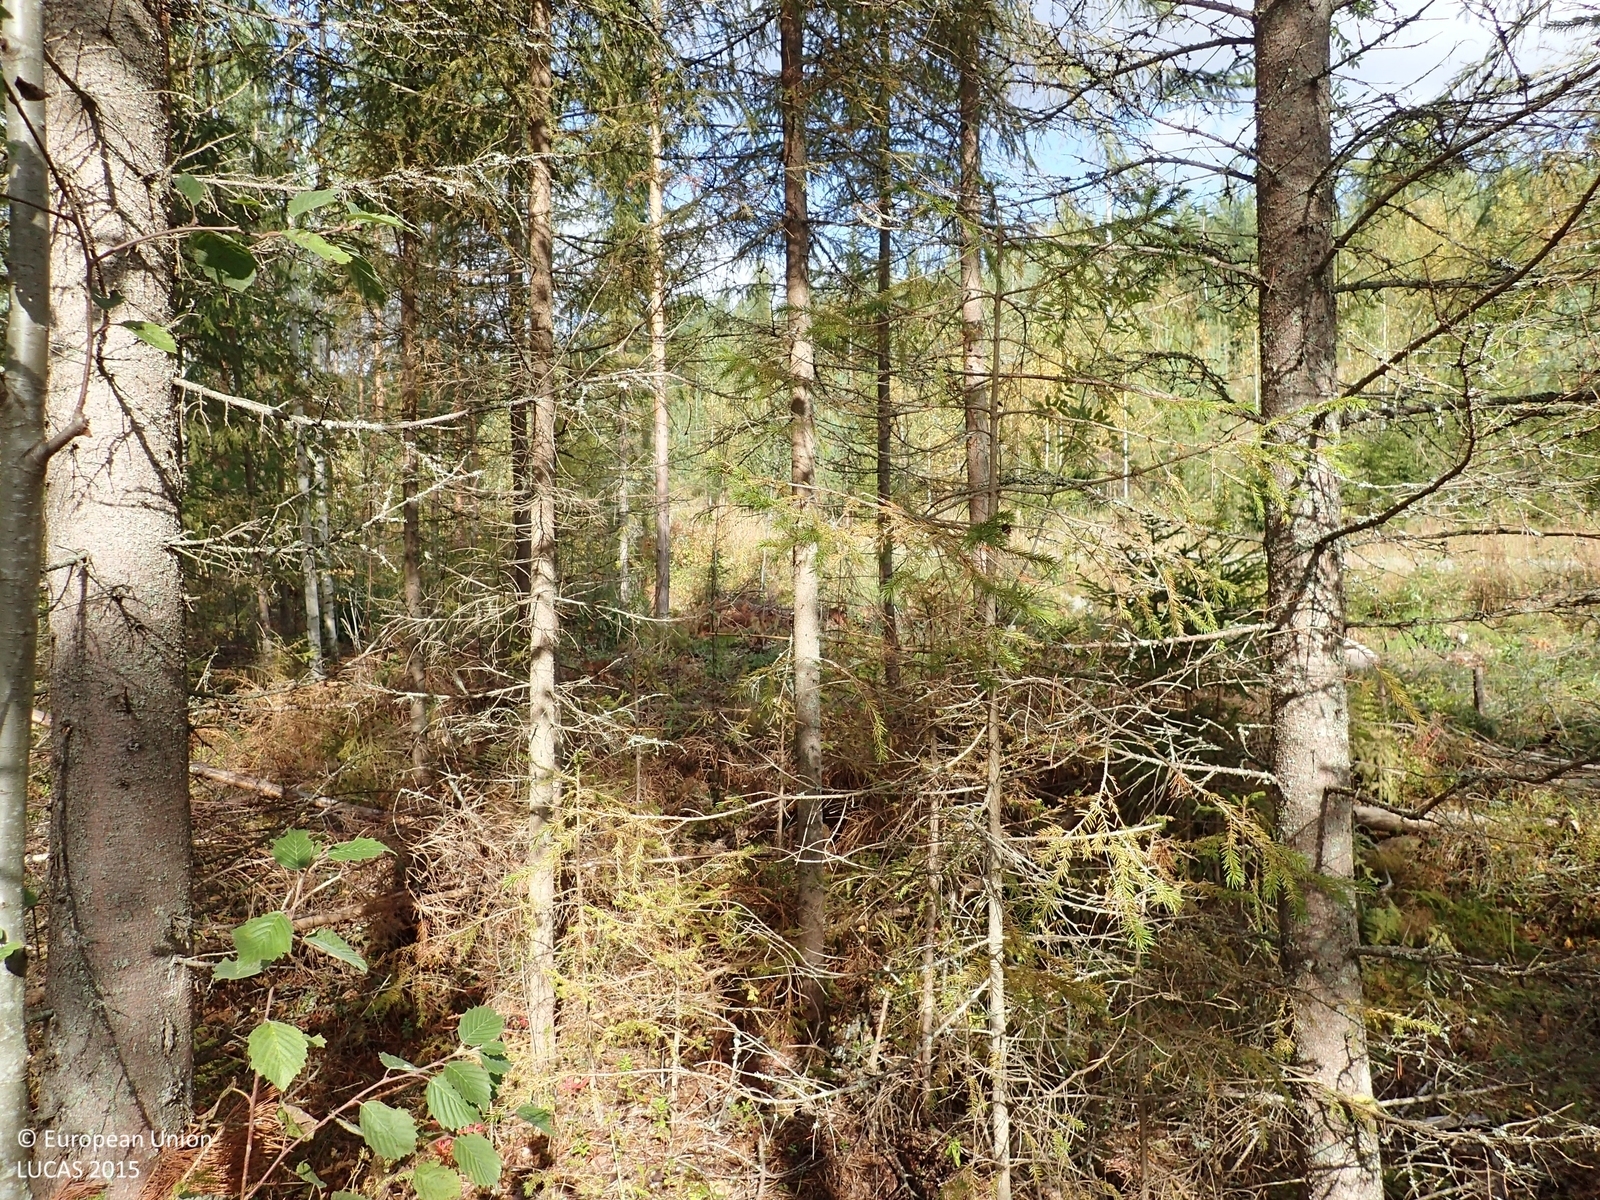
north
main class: Woodland
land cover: Spruce dominated mixed woodland
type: boreal forest
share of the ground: > 75 %
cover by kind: coniferous forest trees 55 %, broadleaved forest trees 20 %, shrubs 15 %, herbaceous plants 5 %, lichens and mosses 5 %
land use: Forestry
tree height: > 5 m
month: September
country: FI
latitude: 63.1296
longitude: 25.1495
